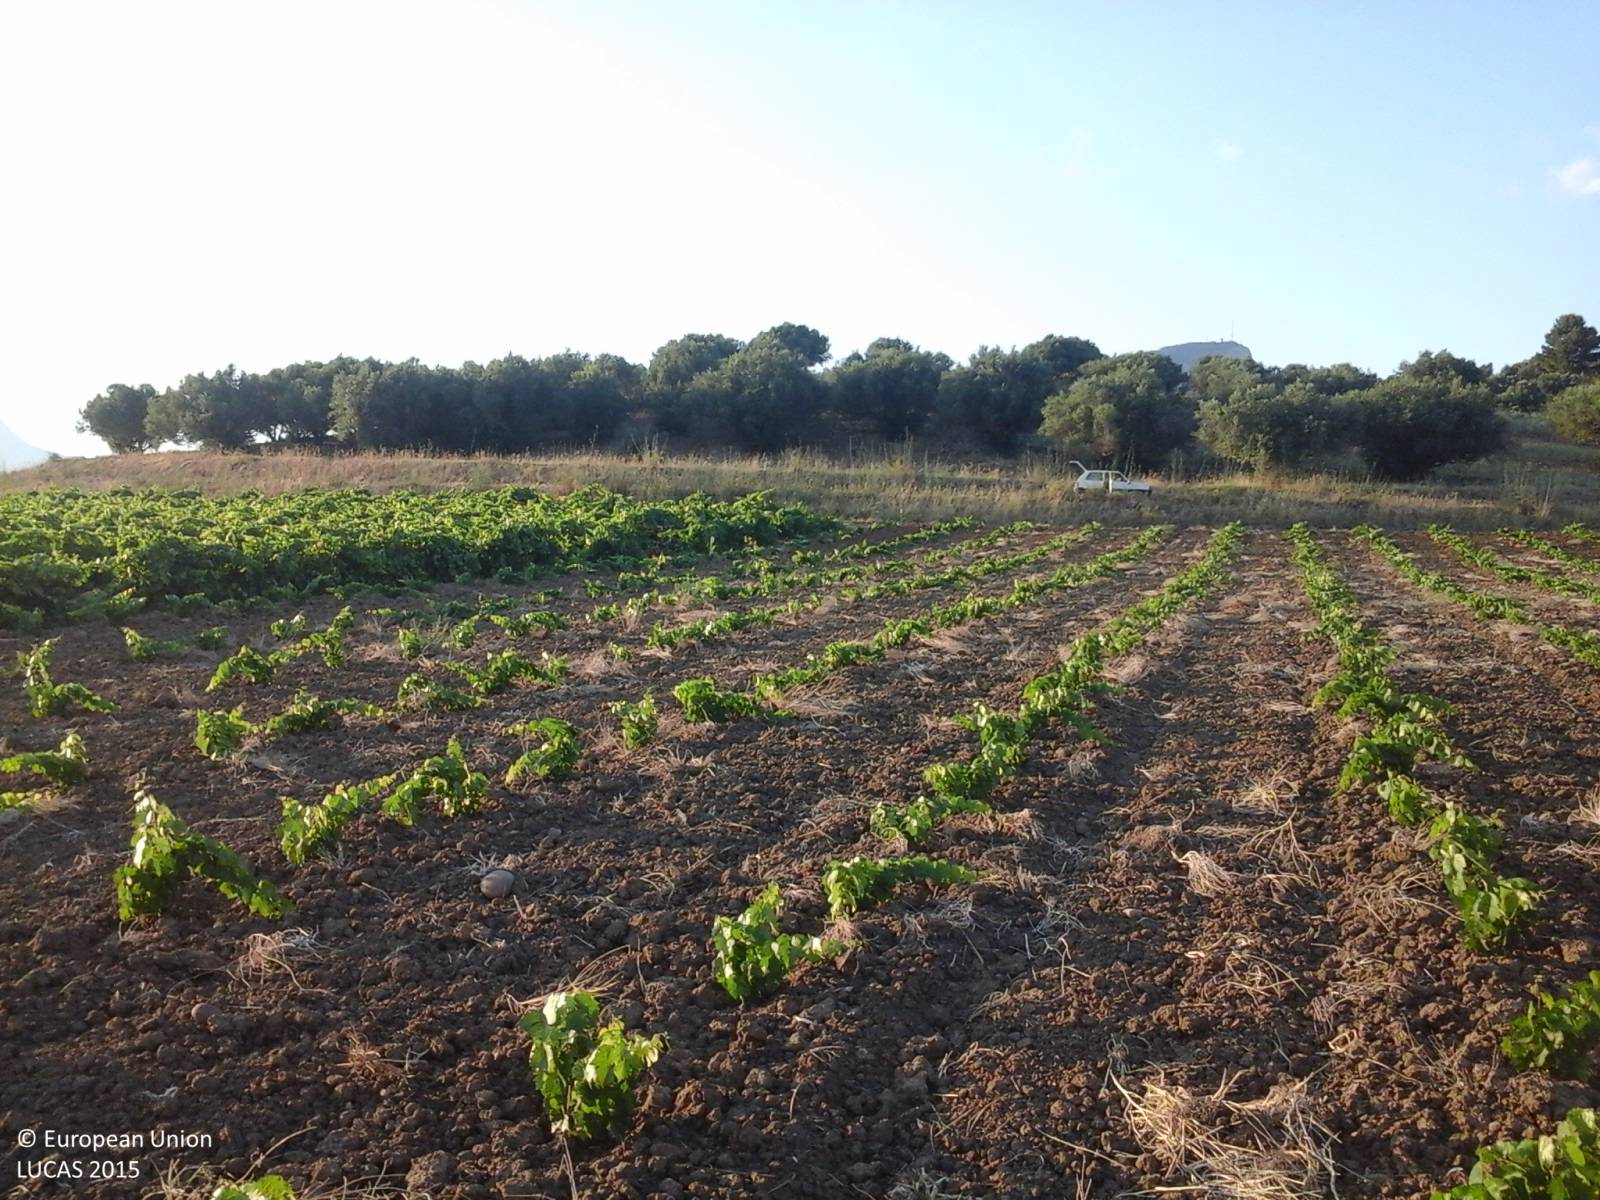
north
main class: Cropland
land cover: Vineyards
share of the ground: < 10 %
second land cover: Other bare soil
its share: > 75 %
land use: Agriculture (excluding fallow land and kitchen gardens)
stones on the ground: < 10 %
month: July
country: IT
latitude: 37.9017
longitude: 12.9468
